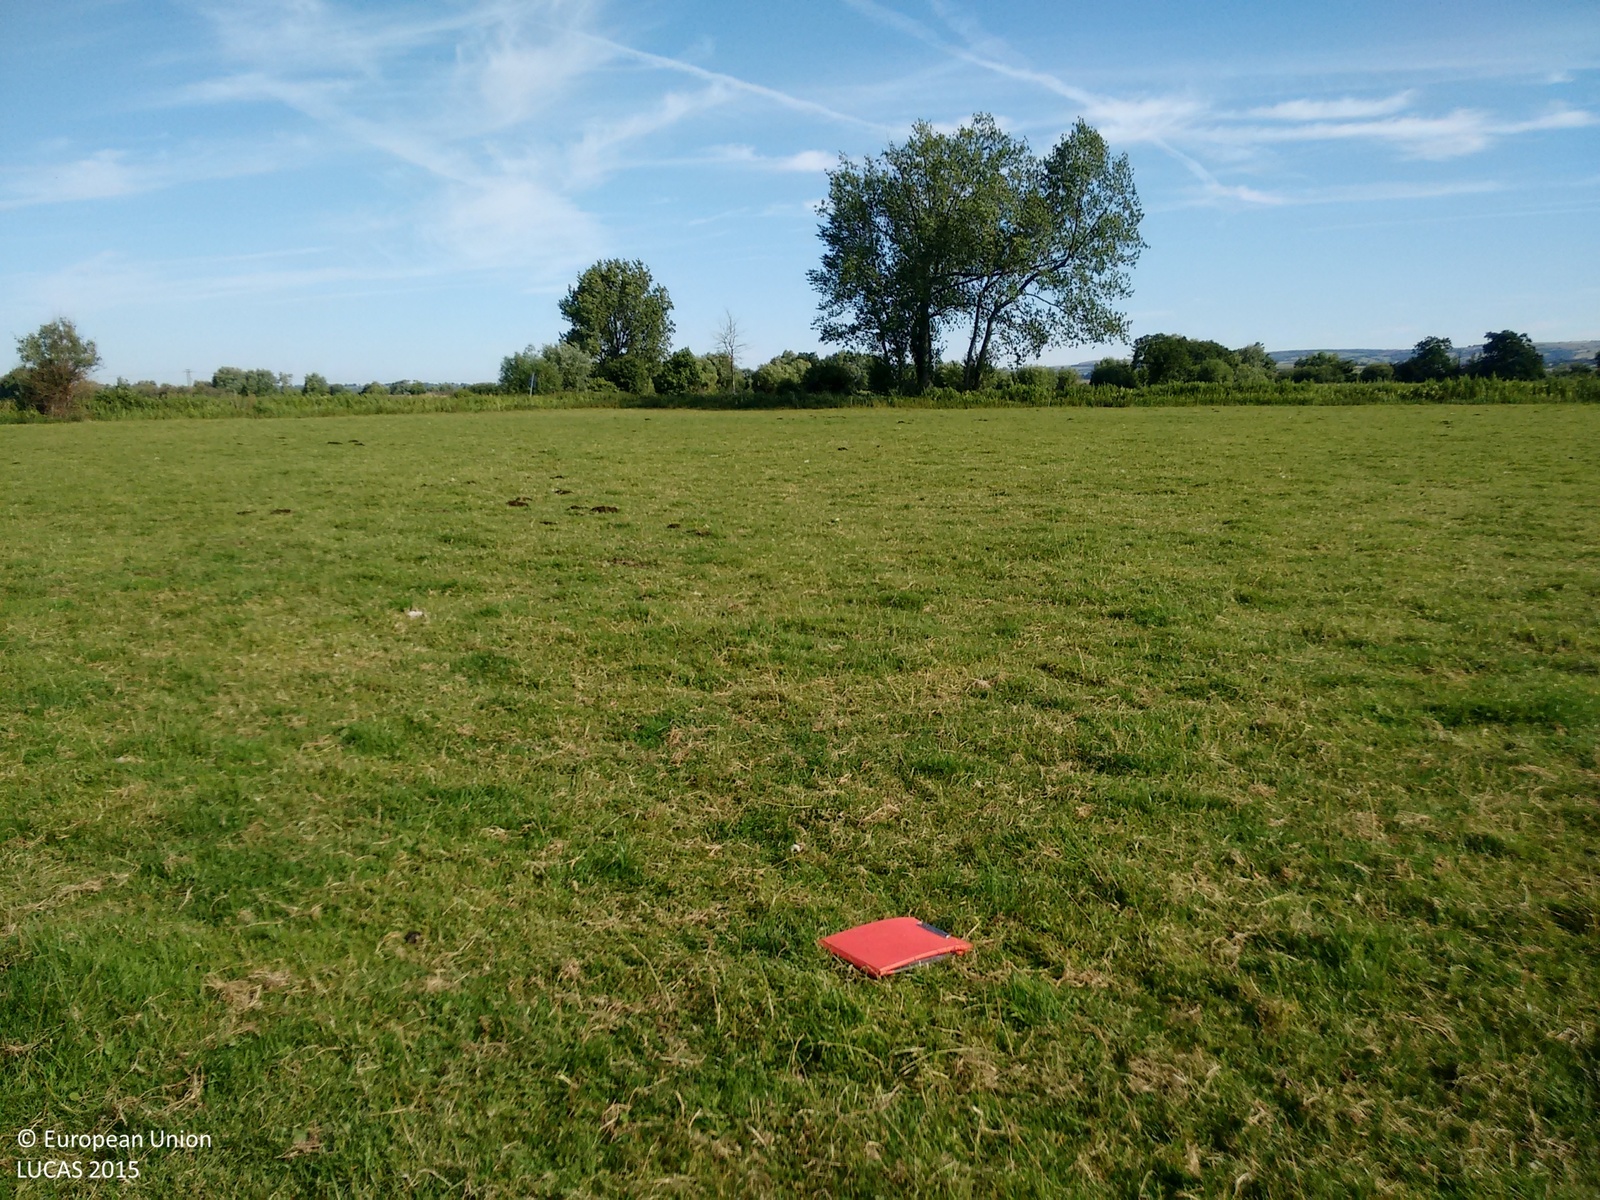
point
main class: Grassland
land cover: Grassland without tree/shrub cover
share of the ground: > 75 %
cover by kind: herbaceous plants 100 %
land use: Agriculture (excluding fallow land and kitchen gardens)
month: July
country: GB
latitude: 51.1610
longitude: -2.7251
